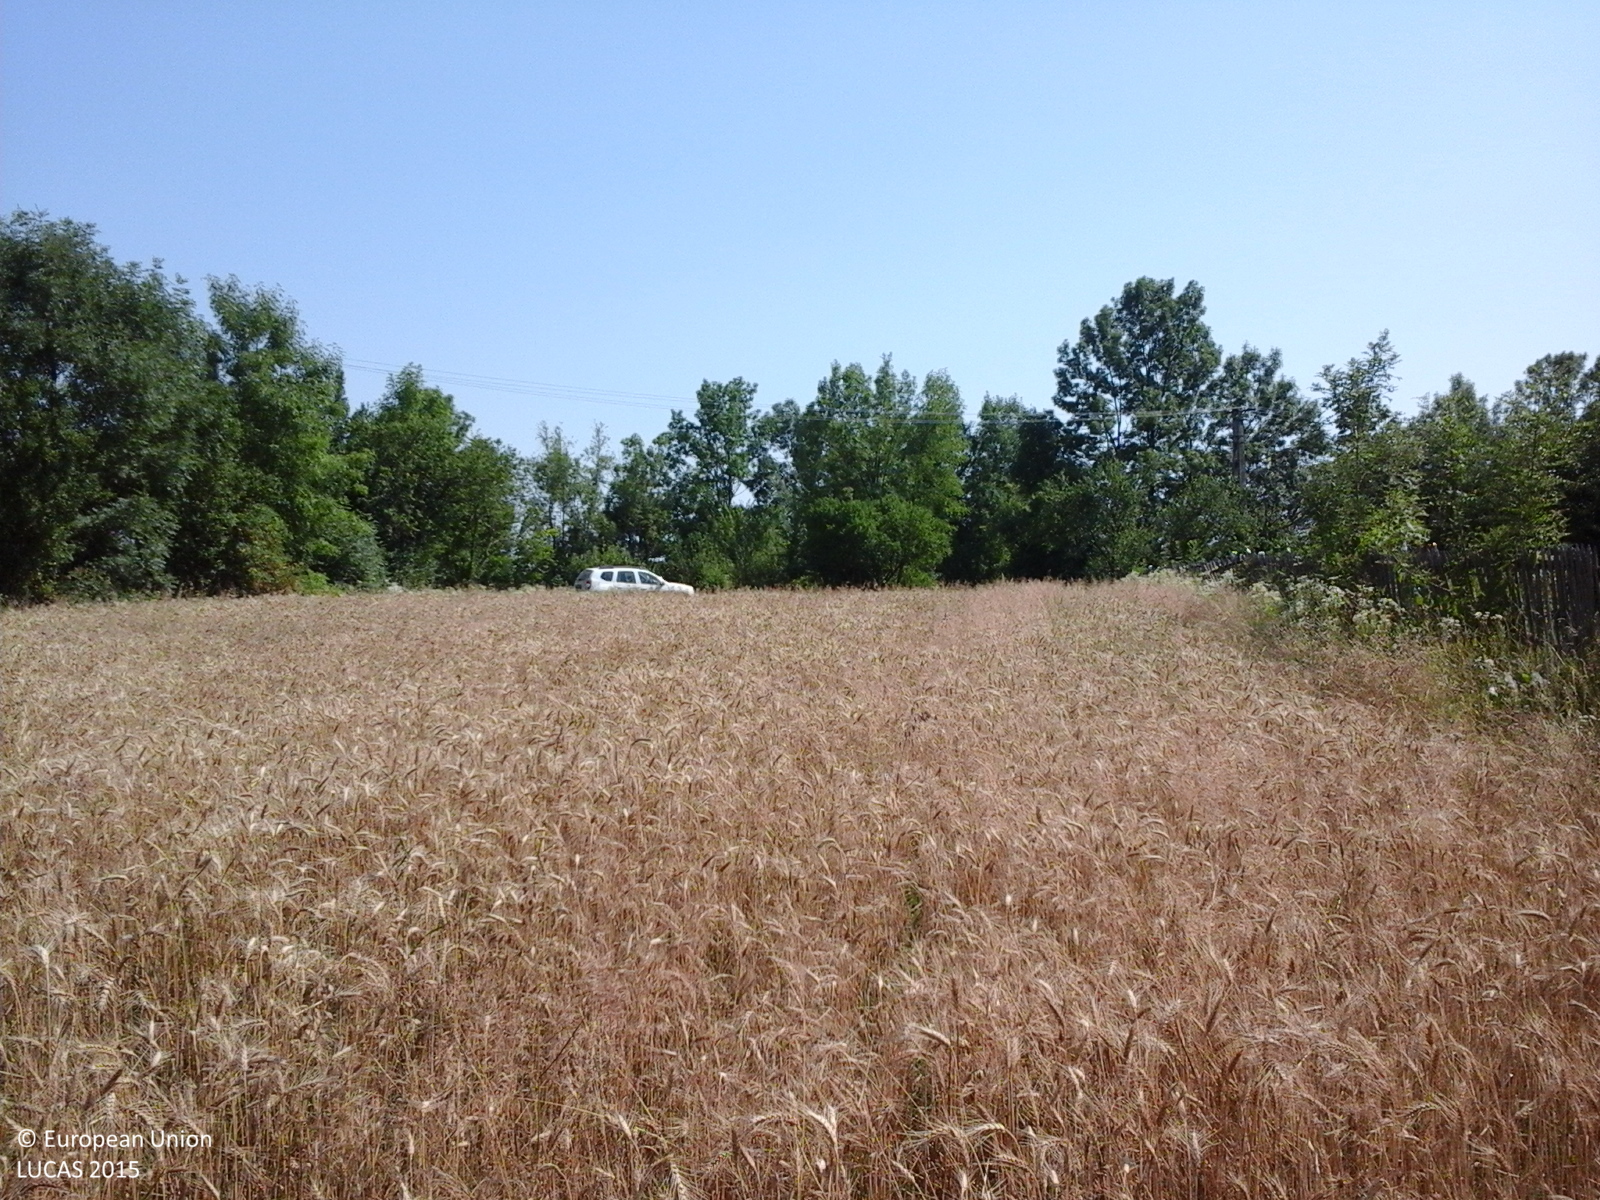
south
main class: Cropland
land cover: Common wheat
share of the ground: > 75 %
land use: Agriculture (excluding fallow land and kitchen gardens)
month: July
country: RO
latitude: 44.7164
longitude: 24.6307
